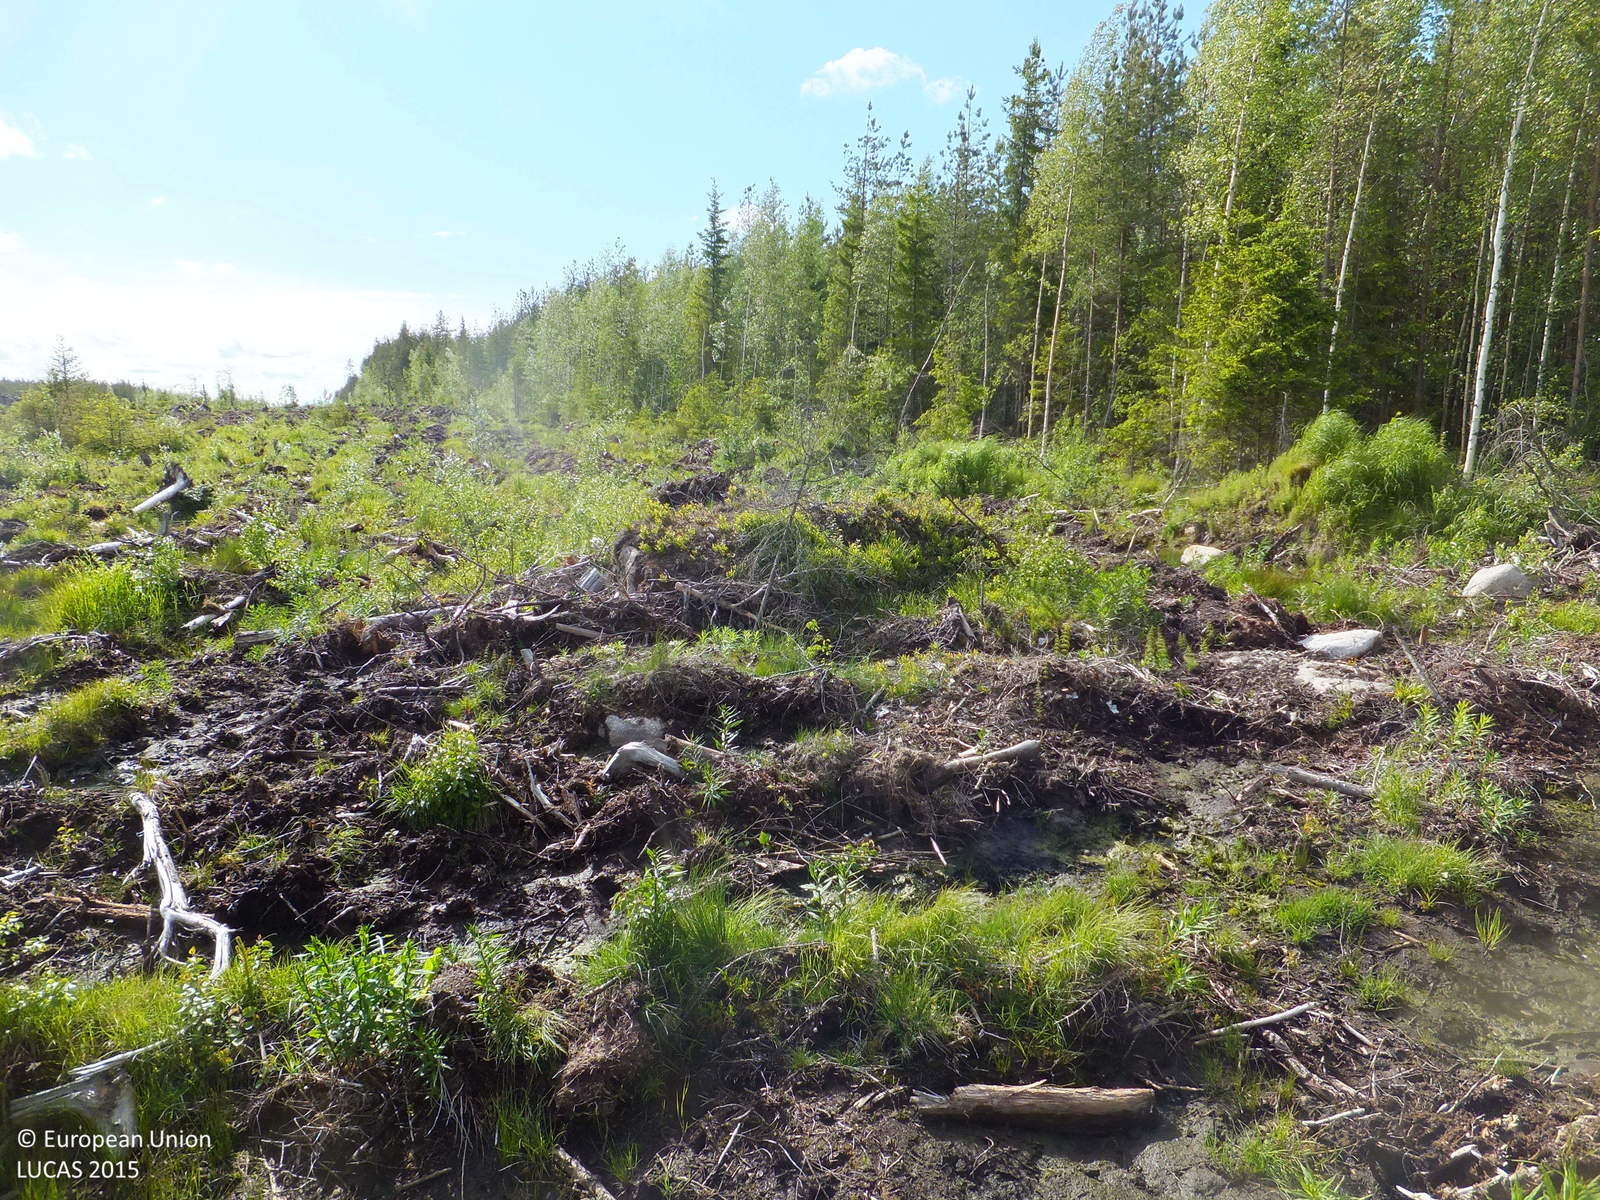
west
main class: Grassland
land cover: Spontaneously vegetated surfaces
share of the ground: 50 - 75 %
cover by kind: herbaceous plants 60 %, unconsolidated bare surface 35 %, shrubs 5 %
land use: Forestry
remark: Clear cut
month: June
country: FI
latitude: 63.2733
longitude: 22.7885
